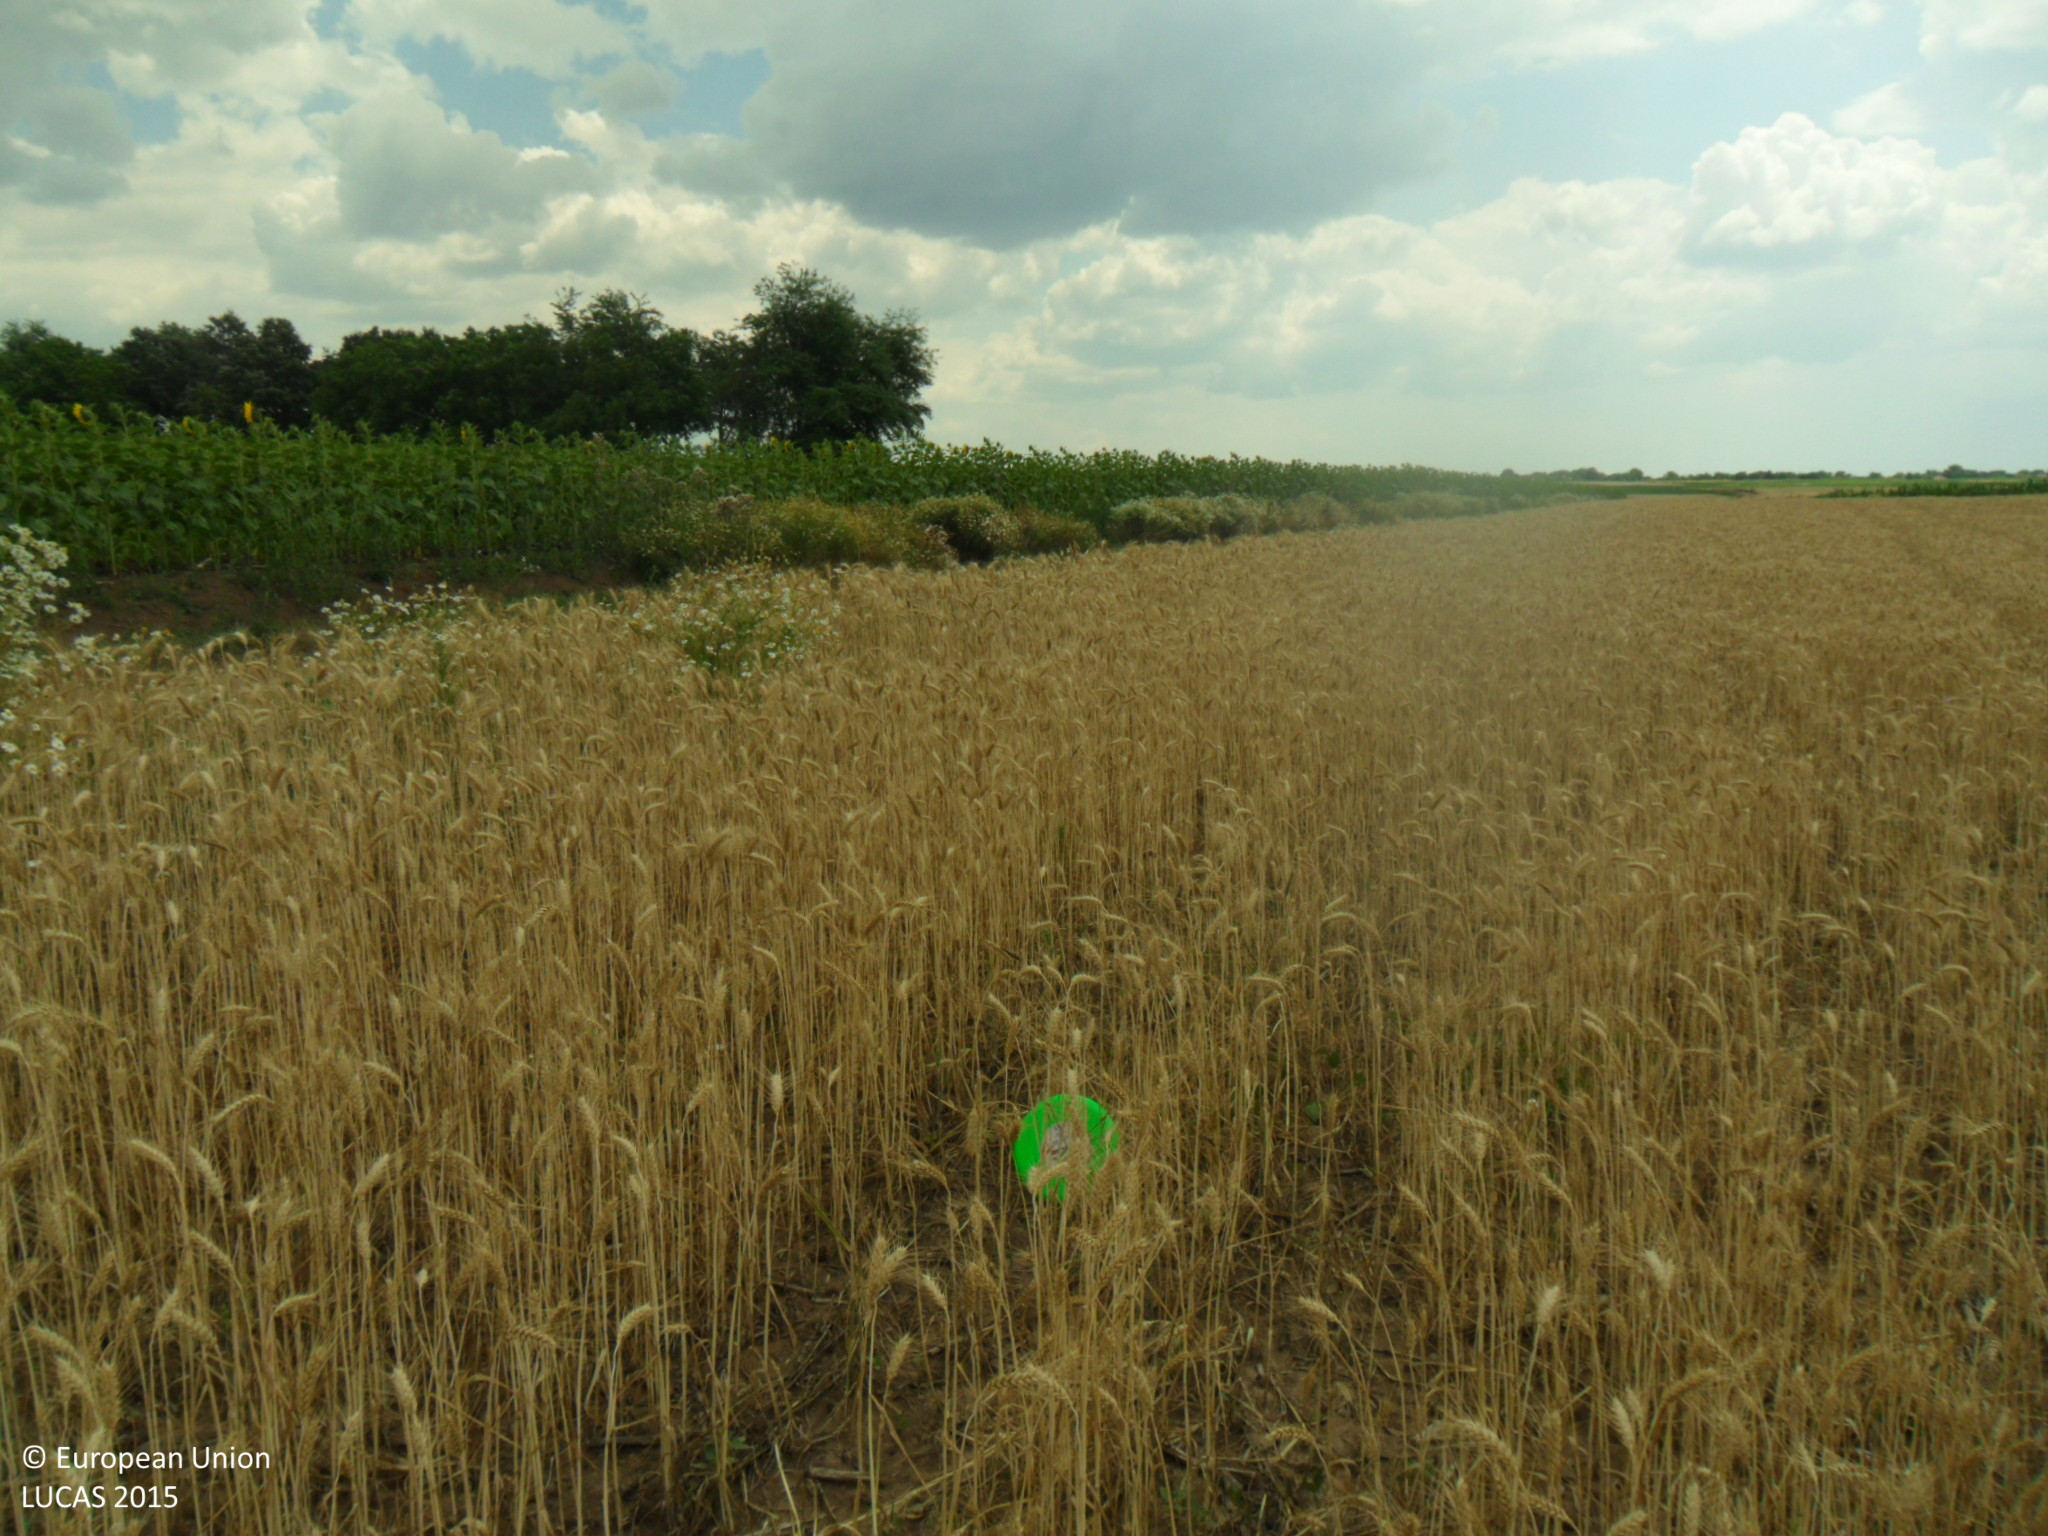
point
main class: Cropland
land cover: Common wheat
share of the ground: > 75 %
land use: Agriculture (excluding fallow land and kitchen gardens)
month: July
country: BG
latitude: 43.6431
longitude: 26.8382
